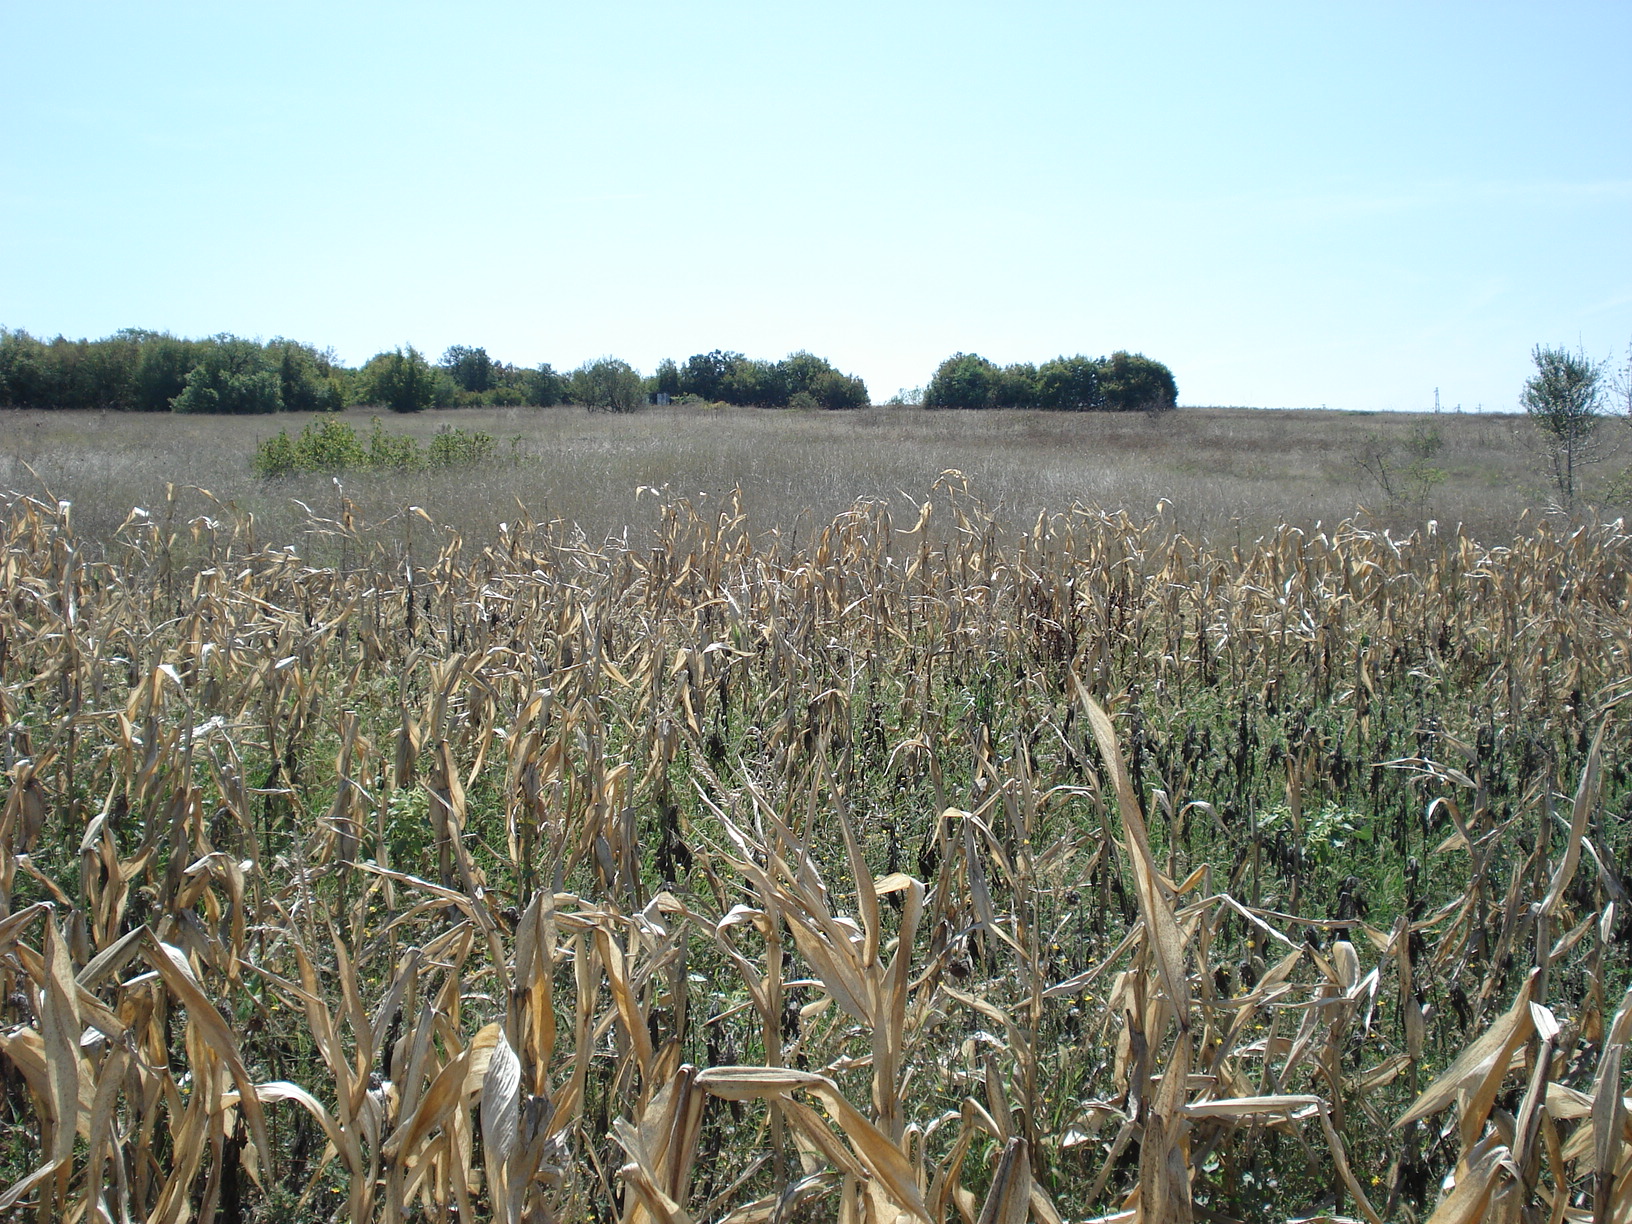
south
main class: Cropland
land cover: Maize
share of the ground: > 75 %
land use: Agriculture (excluding fallow land and kitchen gardens)
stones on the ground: < 10 %
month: September
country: BG
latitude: 43.1478
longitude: 25.3338
